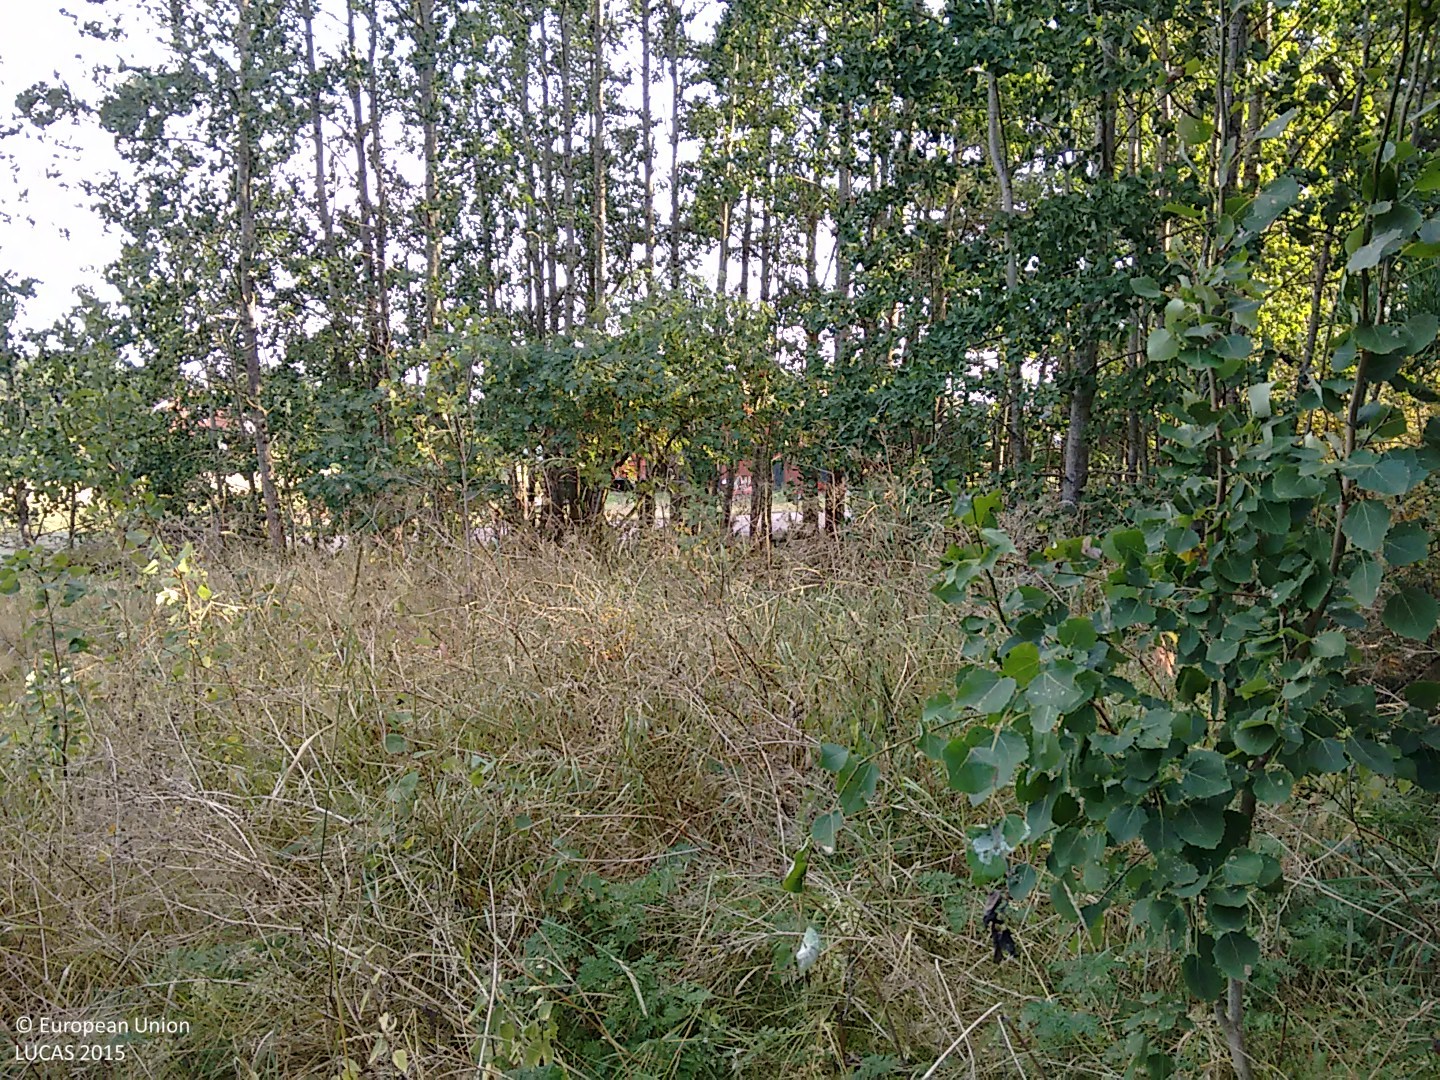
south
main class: Woodland
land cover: Pine dominated mixed woodland
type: hemiboreal forest and nemoral coniferous forest and mixed broadleaved-coniferous forest
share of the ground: > 75 %
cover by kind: coniferous forest trees 65 %, broadleaved forest trees 30 %, herbaceous plants 5 %
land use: Forestry
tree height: > 5 m
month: August
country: FI
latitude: 60.0465
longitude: 20.4439
